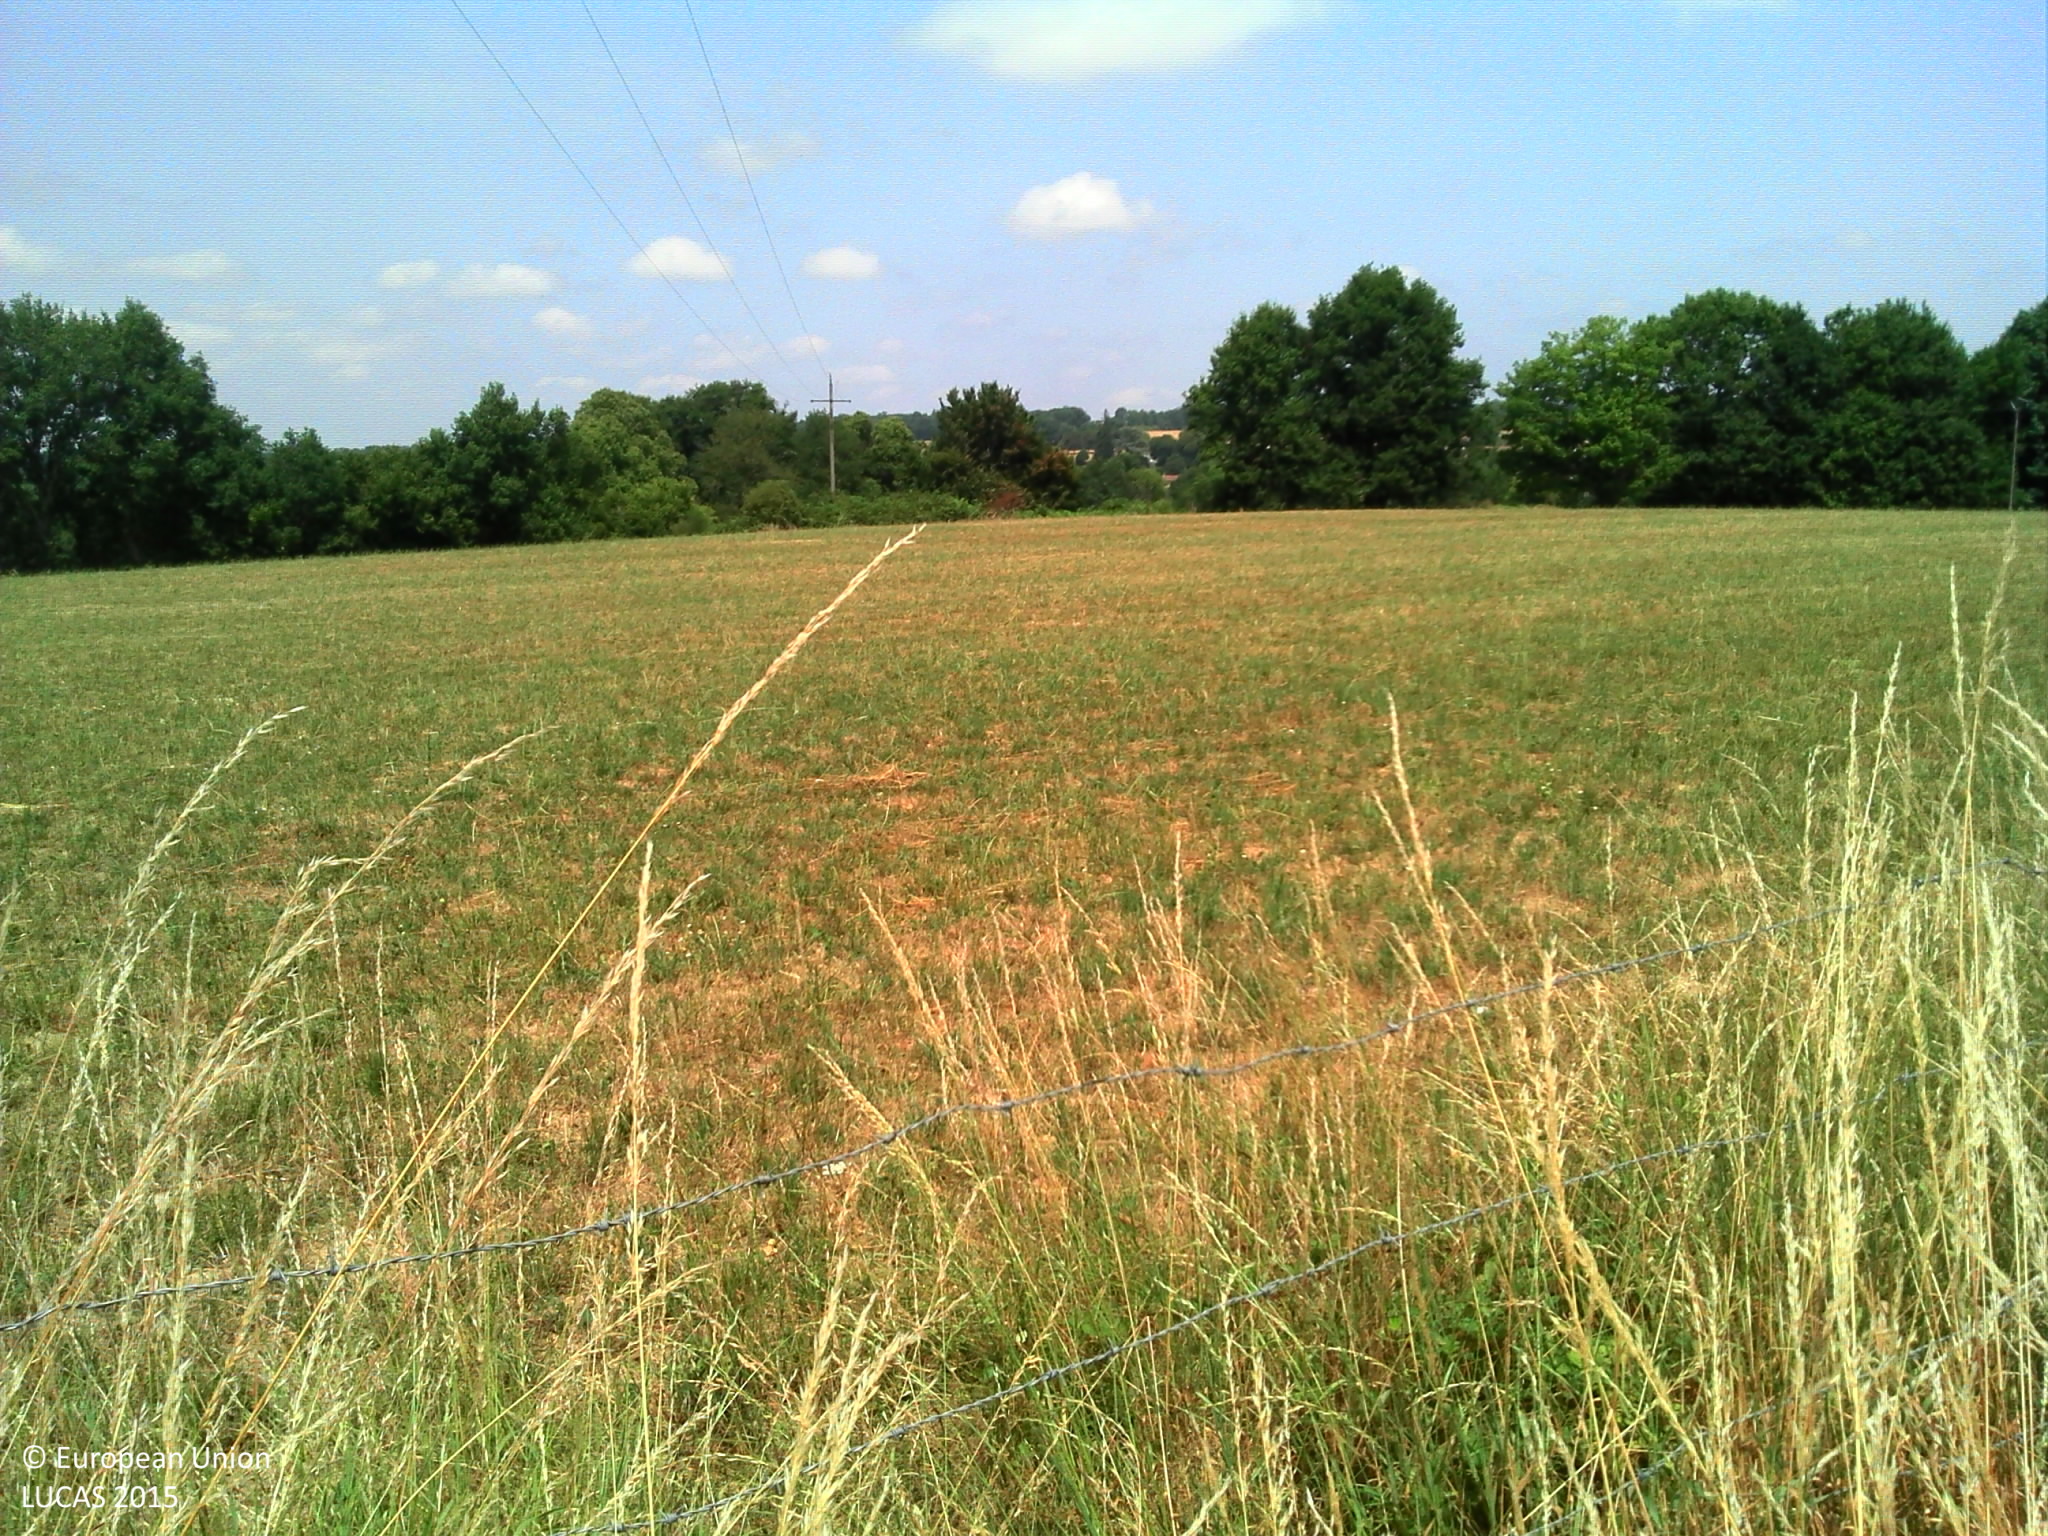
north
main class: Grassland
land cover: Grassland without tree/shrub cover
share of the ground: > 75 %
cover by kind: herbaceous plants 95 %
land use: Agriculture (excluding fallow land and kitchen gardens)
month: July
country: FR
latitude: 45.7340
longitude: 0.9809
